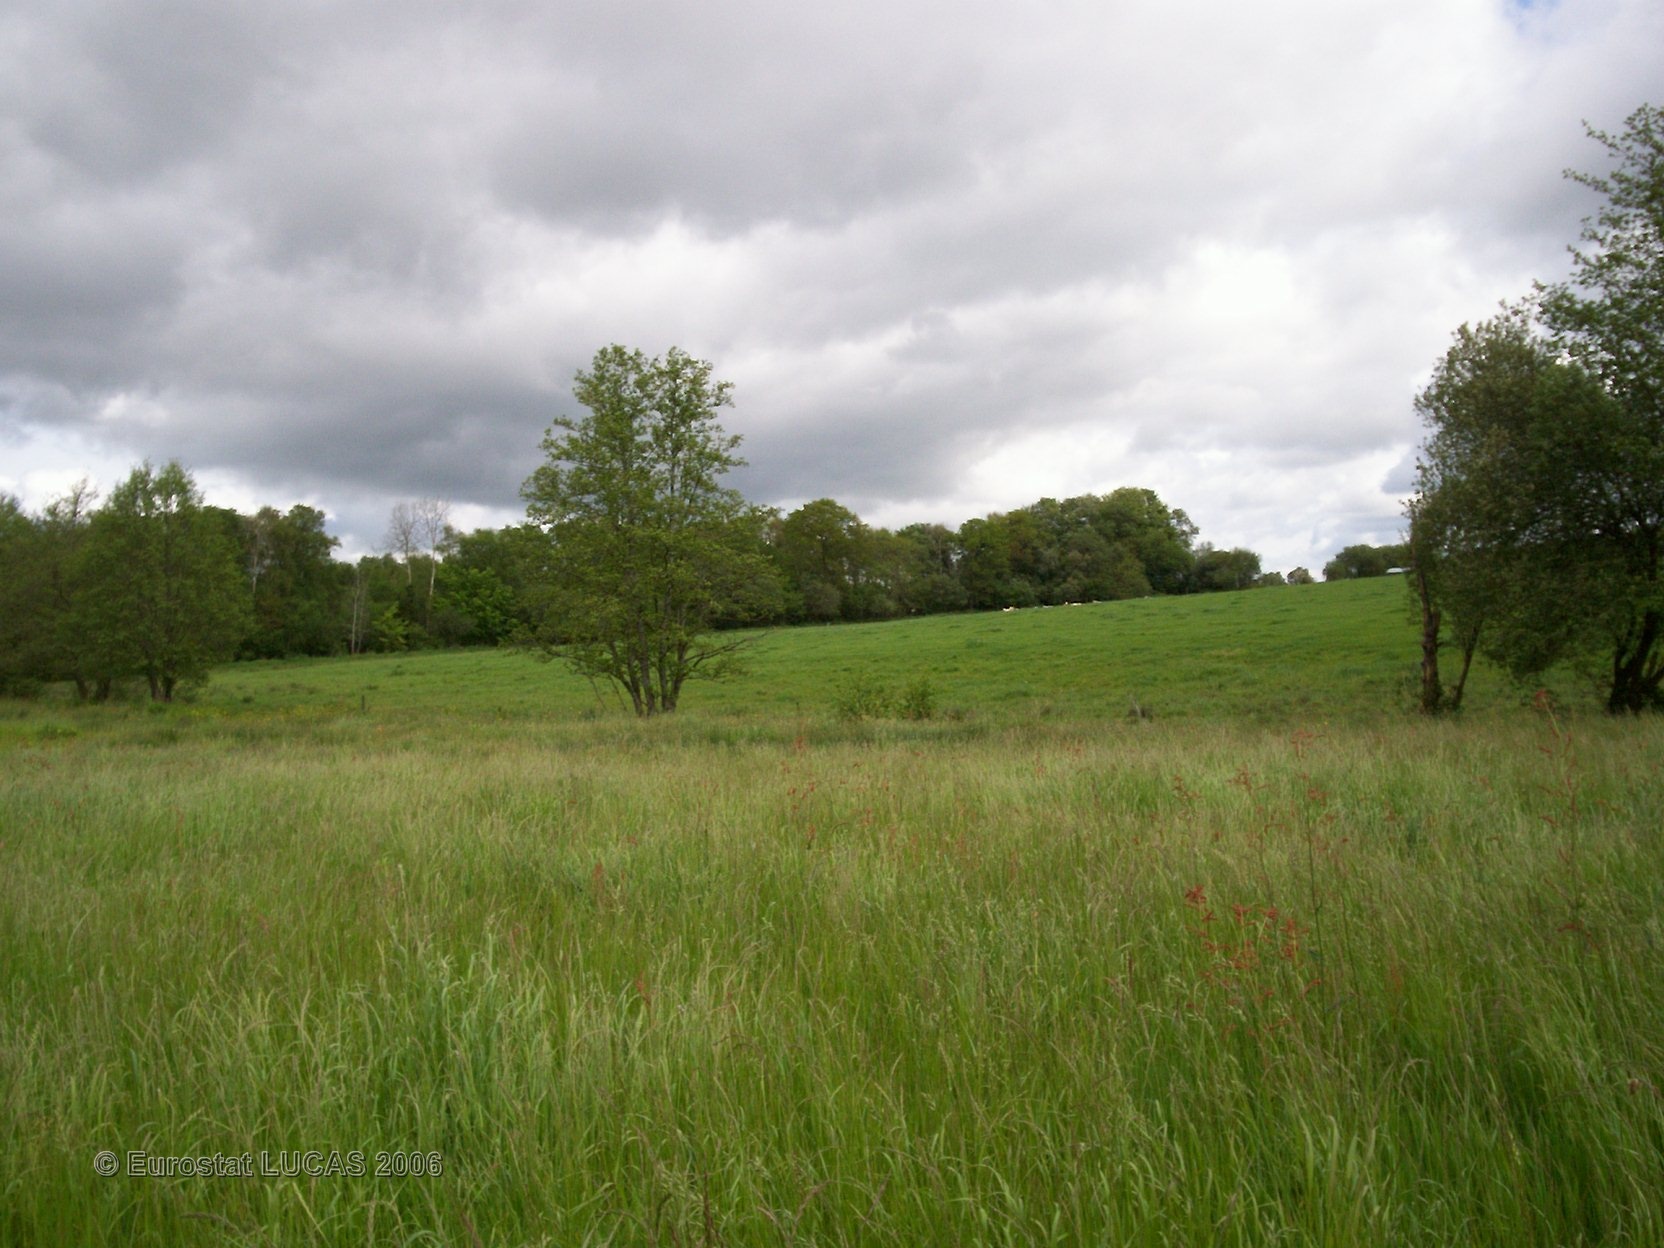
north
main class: Grassland
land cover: Grassland without tree/shrub cover
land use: Agriculture (excluding fallow land and kitchen gardens)
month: May
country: FR
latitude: 48.5816
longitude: -3.7341
